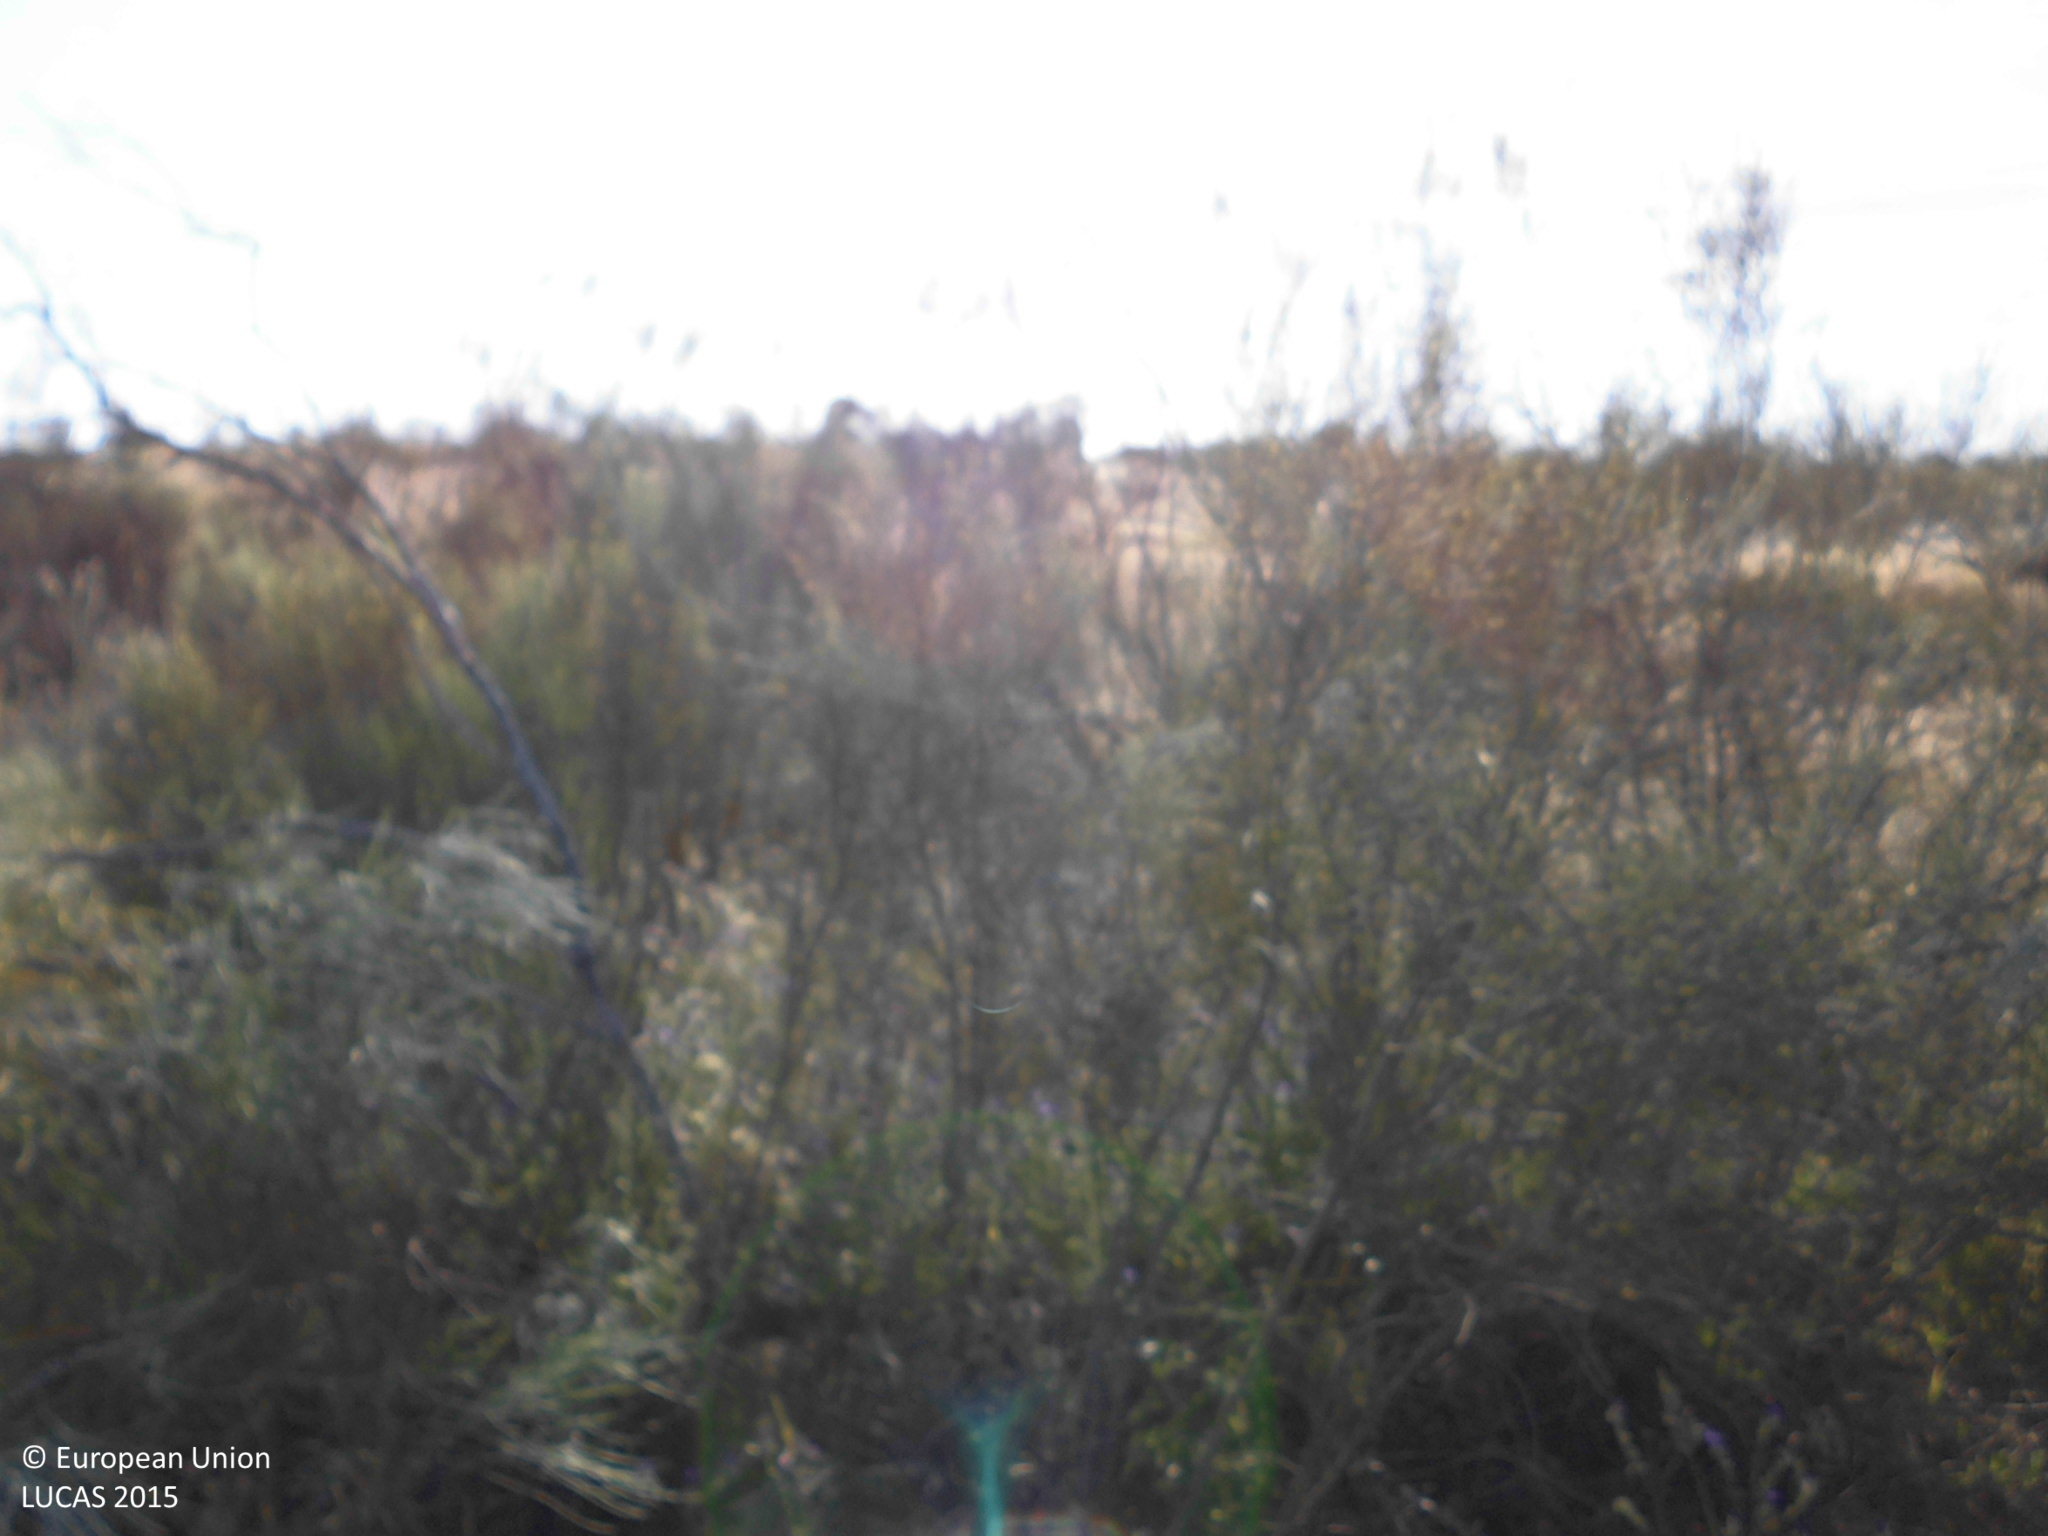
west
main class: Shrubland
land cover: Shrubland without tree cover
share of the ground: 25 - 50 %
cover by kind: herbaceous plants 75 %, shrubs 25 %
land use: Agriculture (excluding fallow land and kitchen gardens)
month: May
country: ES
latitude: 39.4886
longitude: -6.0490
